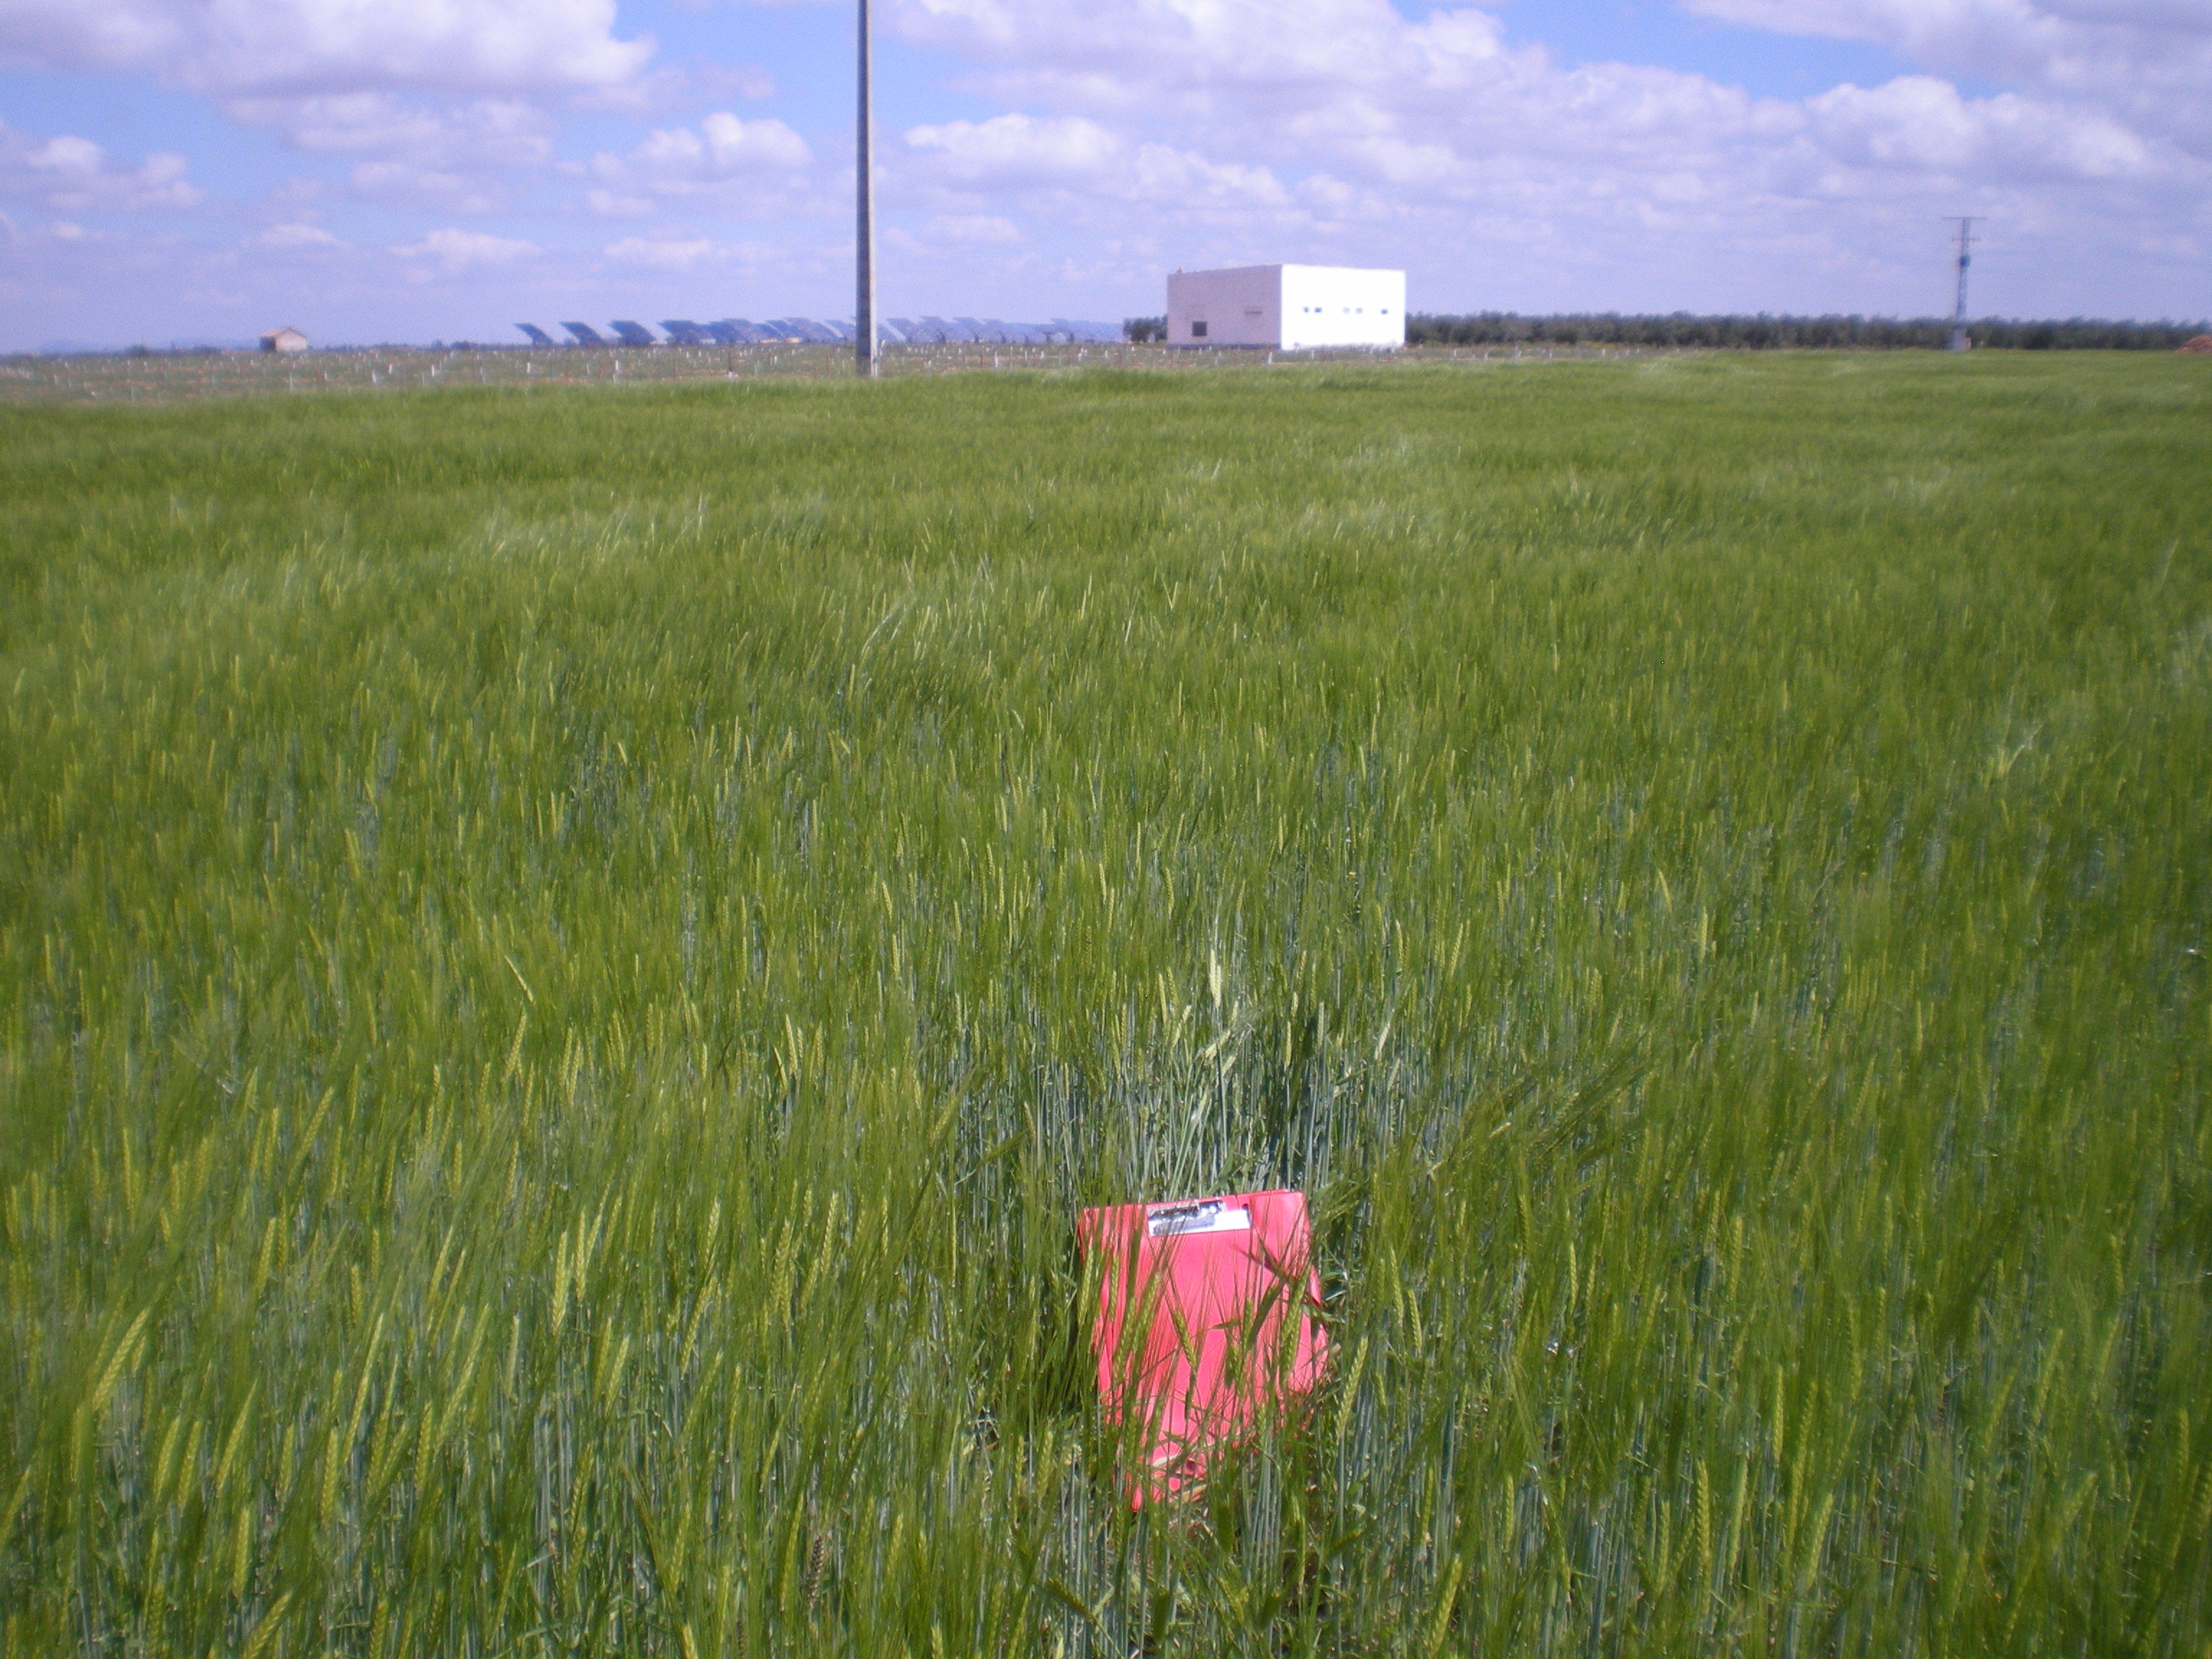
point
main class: Cropland
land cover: Barley
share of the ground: > 75 %
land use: Agriculture (excluding fallow land and kitchen gardens)
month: April
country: ES
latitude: 38.9882
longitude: -3.5815
